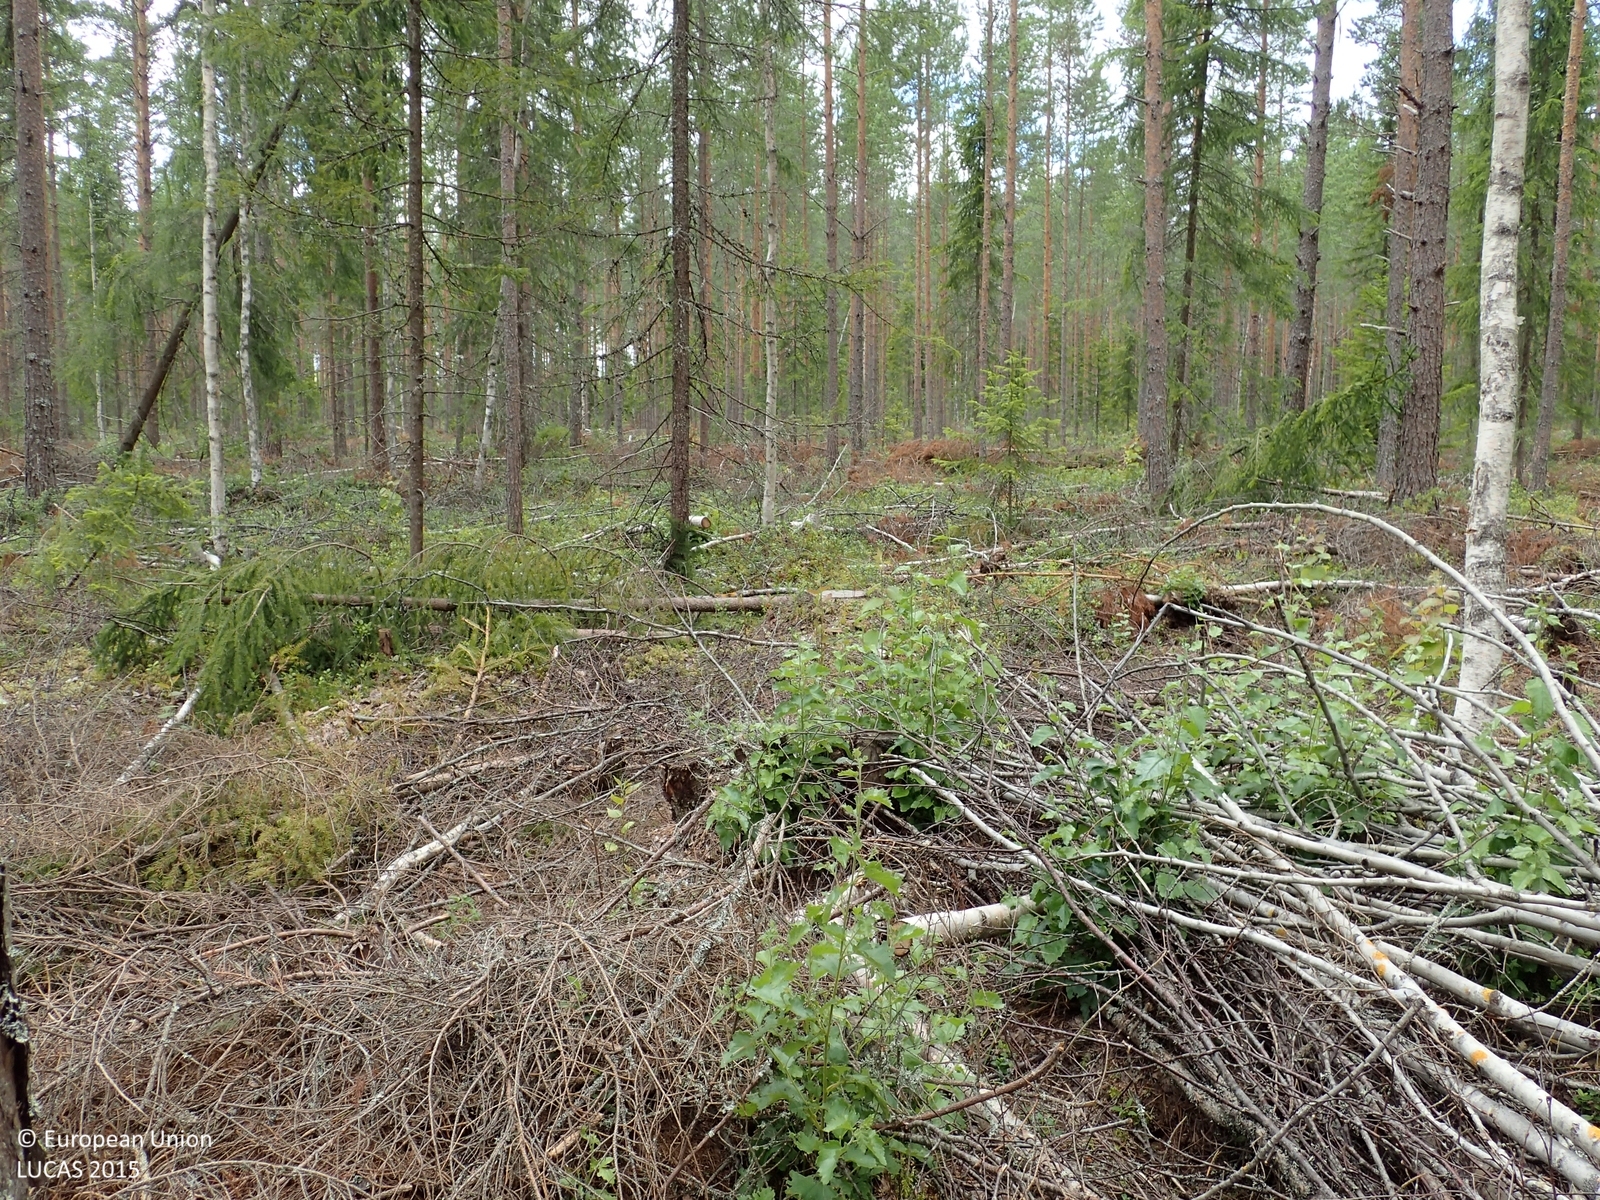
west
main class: Woodland
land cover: Pine dominated coniferous woodland
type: boreal forest
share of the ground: 25 - 50 %
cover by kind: coniferous forest trees 40 %, shrubs 40 %, lichens and mosses 5 %
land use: Forestry
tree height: > 5 m
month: August
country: FI
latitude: 62.6779
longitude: 21.7821
